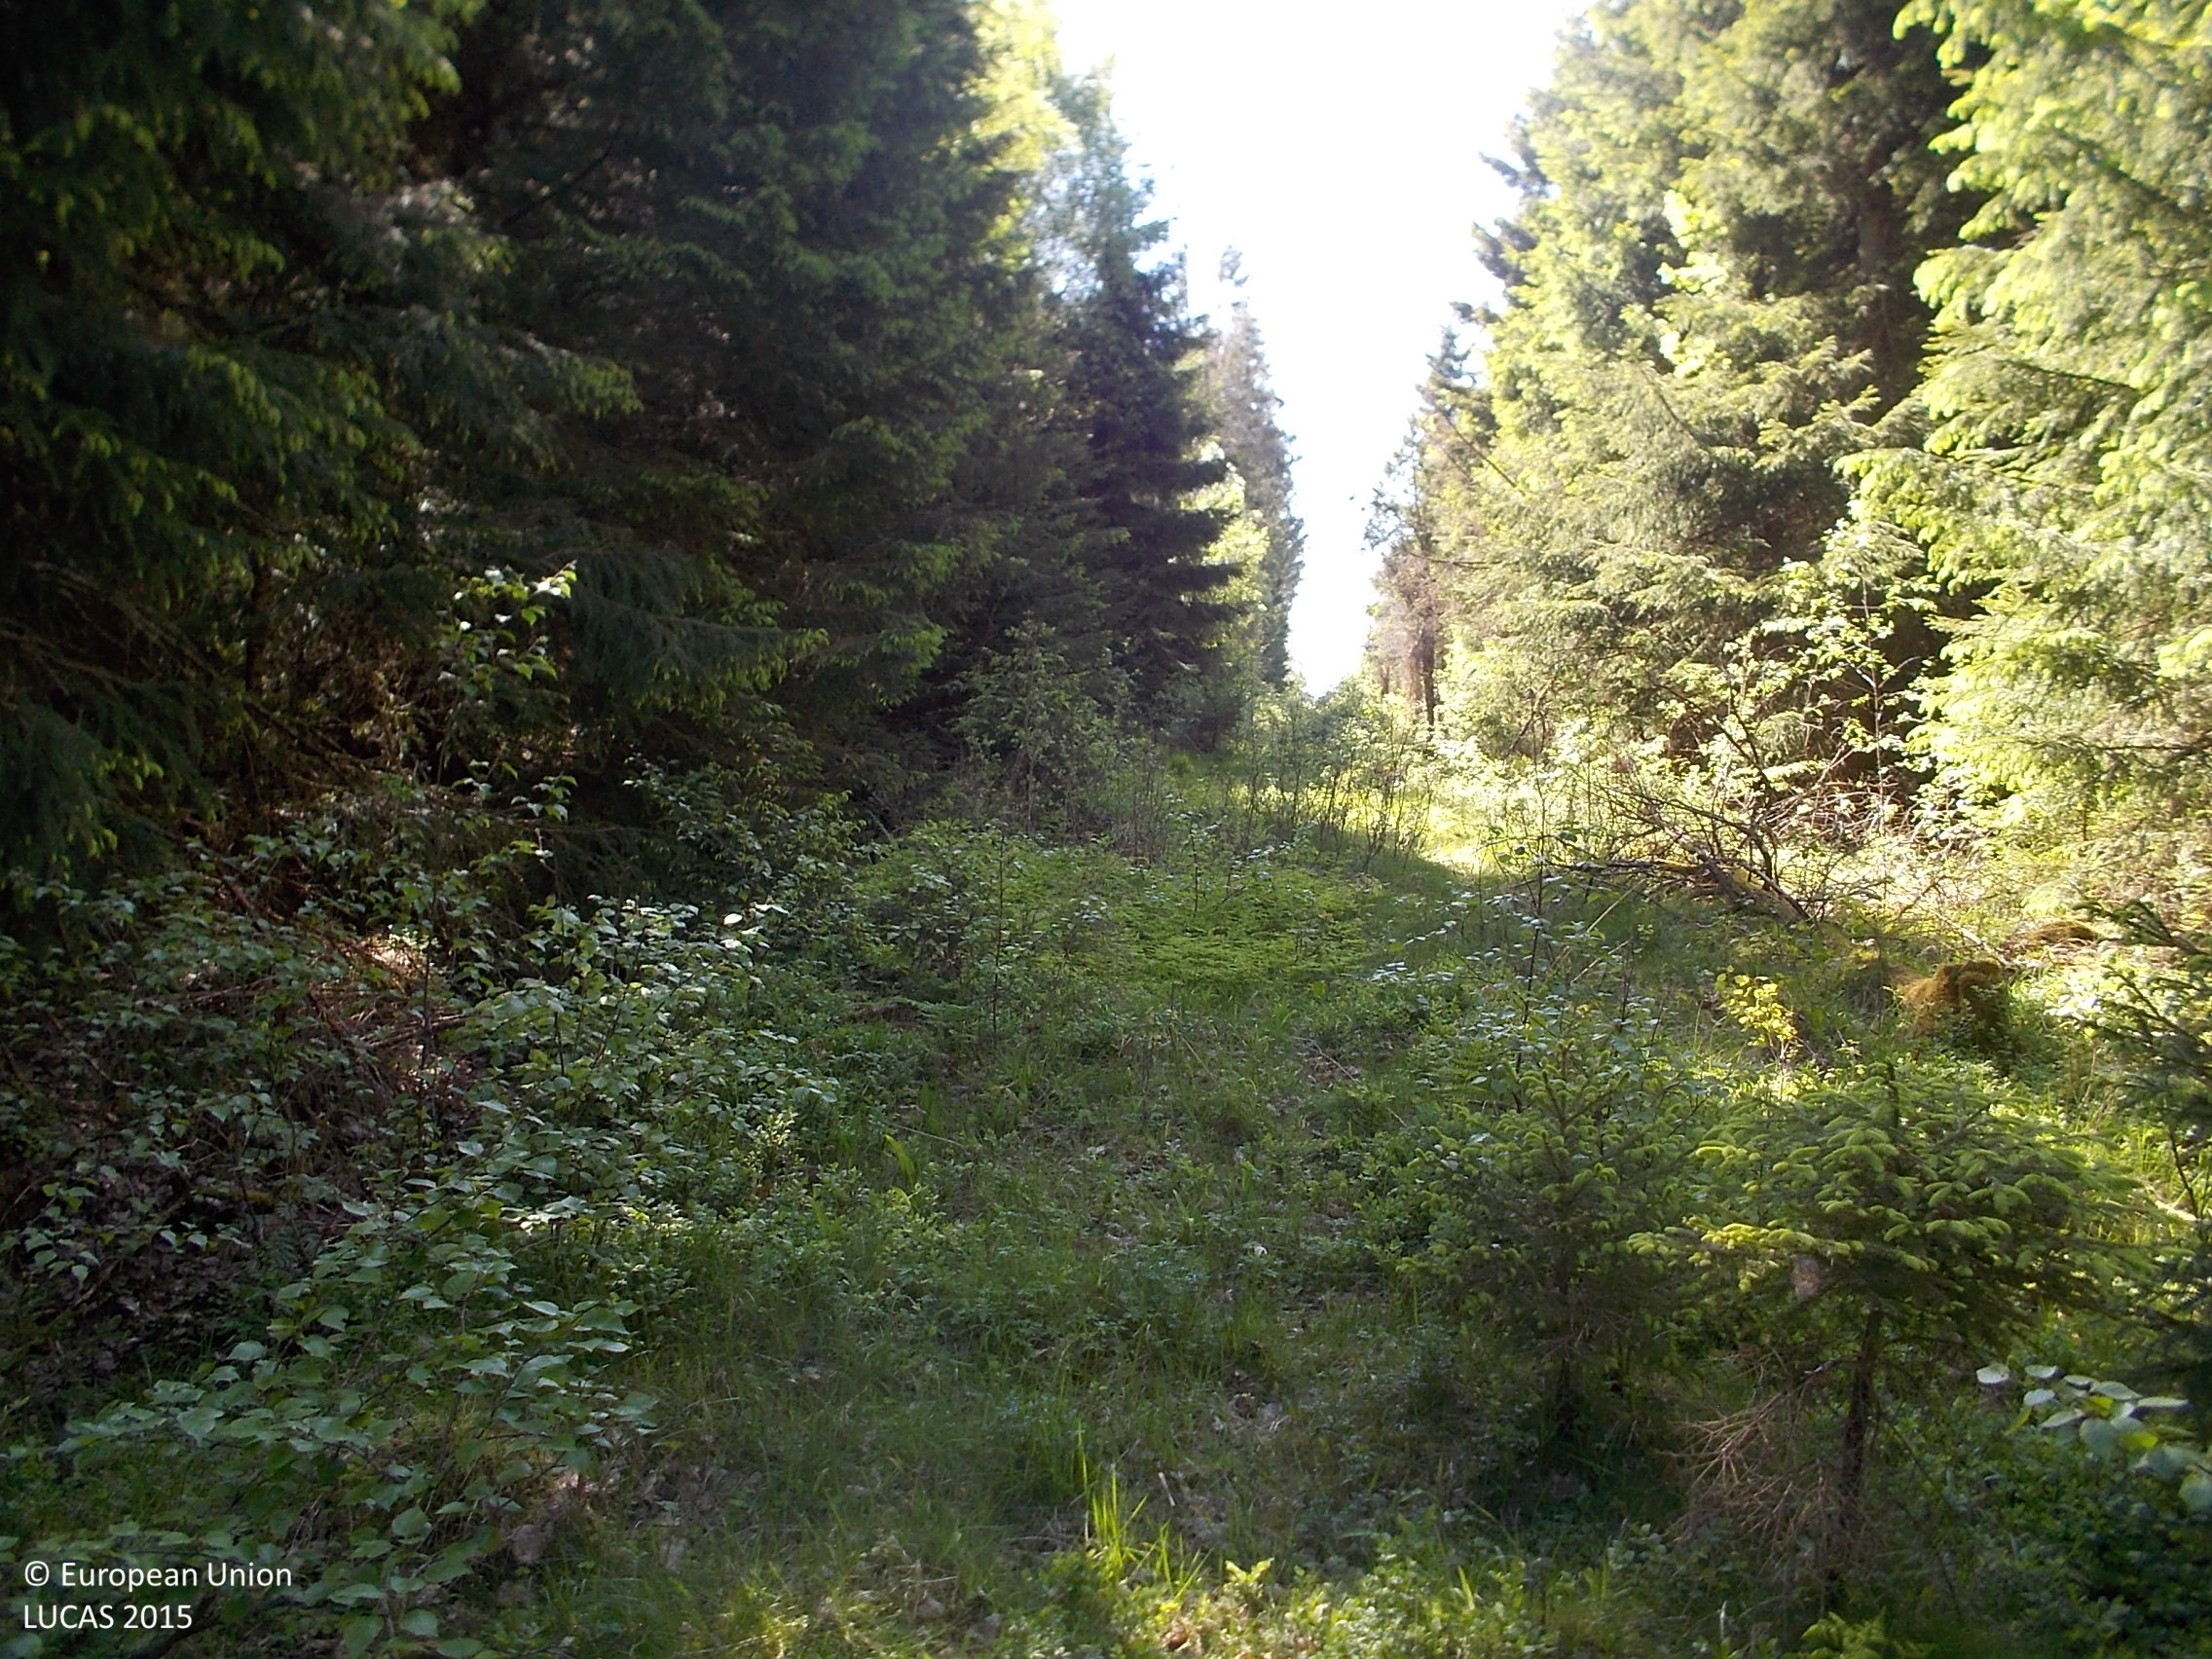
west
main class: Woodland
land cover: Spruce dominated mixed woodland
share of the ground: 25 - 50 %
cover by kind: shrubs 40 %, coniferous forest trees 25 %, broadleaved forest trees 25 %, herbaceous plants 10 %
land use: Forestry
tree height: < 5 m
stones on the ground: < 10 %
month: June
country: SE
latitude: 57.8056
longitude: 13.1085
